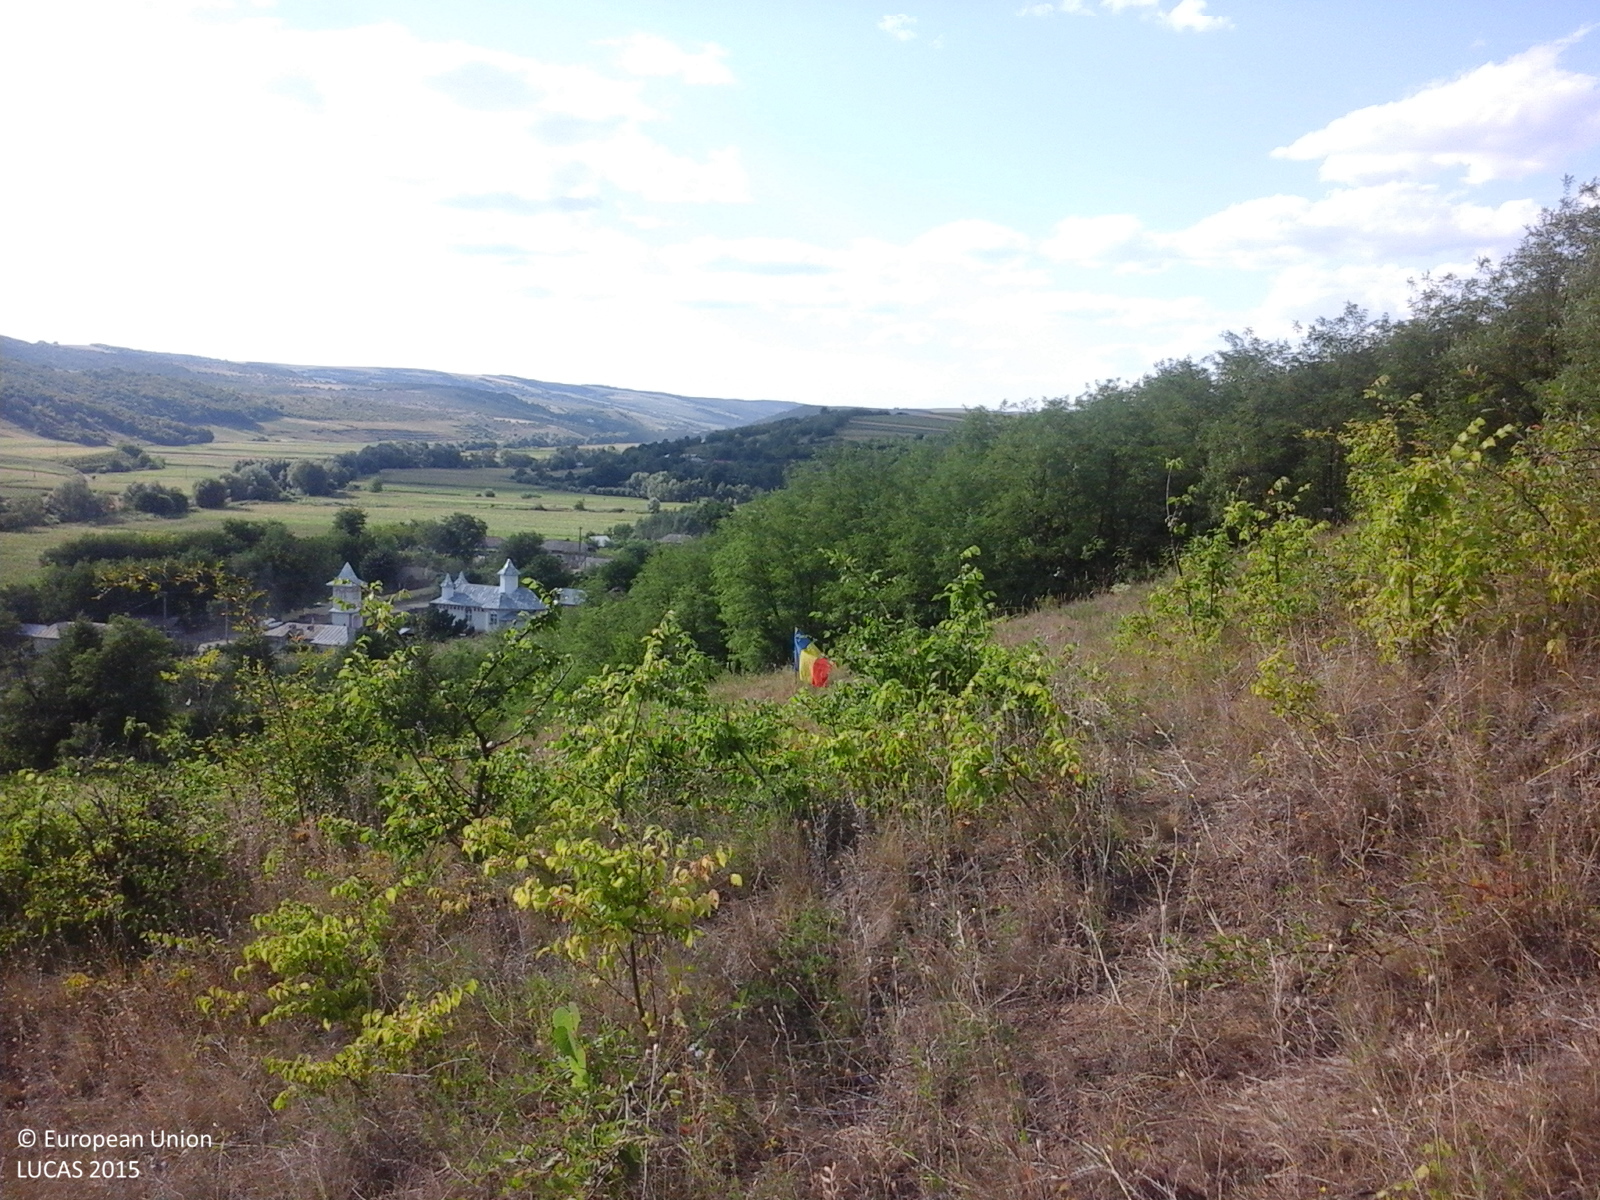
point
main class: Grassland
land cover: Grassland with sparse tree/shrub cover
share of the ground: > 75 %
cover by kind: herbaceous plants 85 %, shrubs 10 %, broadleaved forest trees 5 %
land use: Fallow land
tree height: < 5 m
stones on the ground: < 10 %
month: July
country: RO
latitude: 46.3333
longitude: 27.3700
